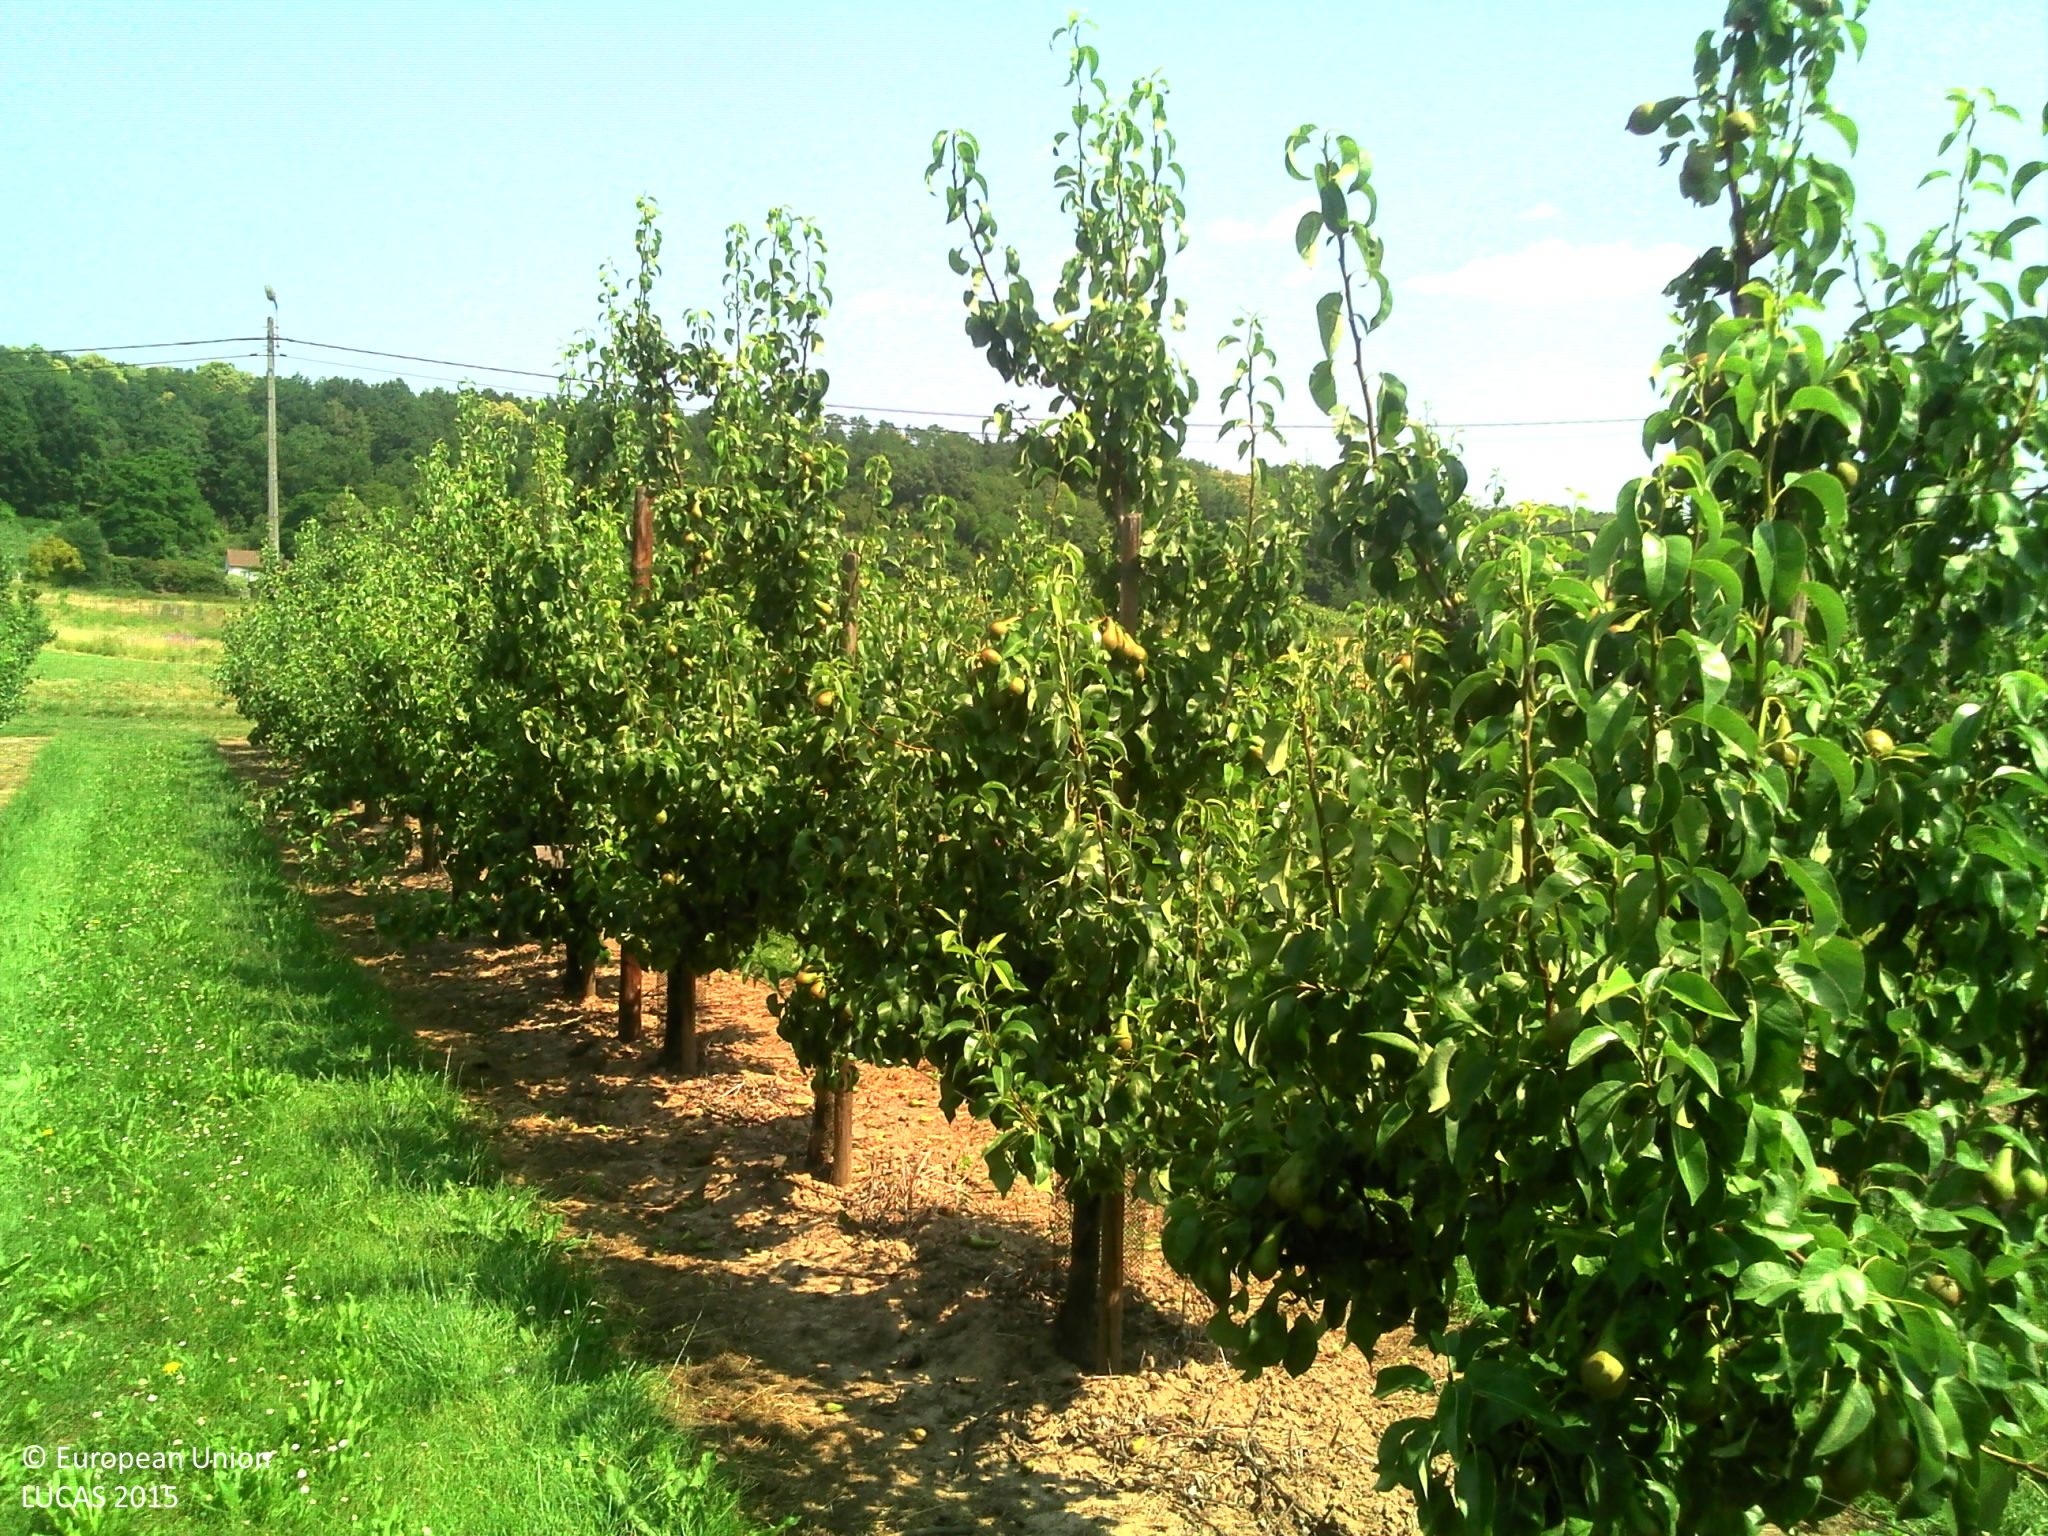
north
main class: Cropland
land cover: Pear fruit
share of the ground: > 75 %
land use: Agriculture (excluding fallow land and kitchen gardens)
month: July
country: BE
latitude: 50.9473
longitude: 4.7728
